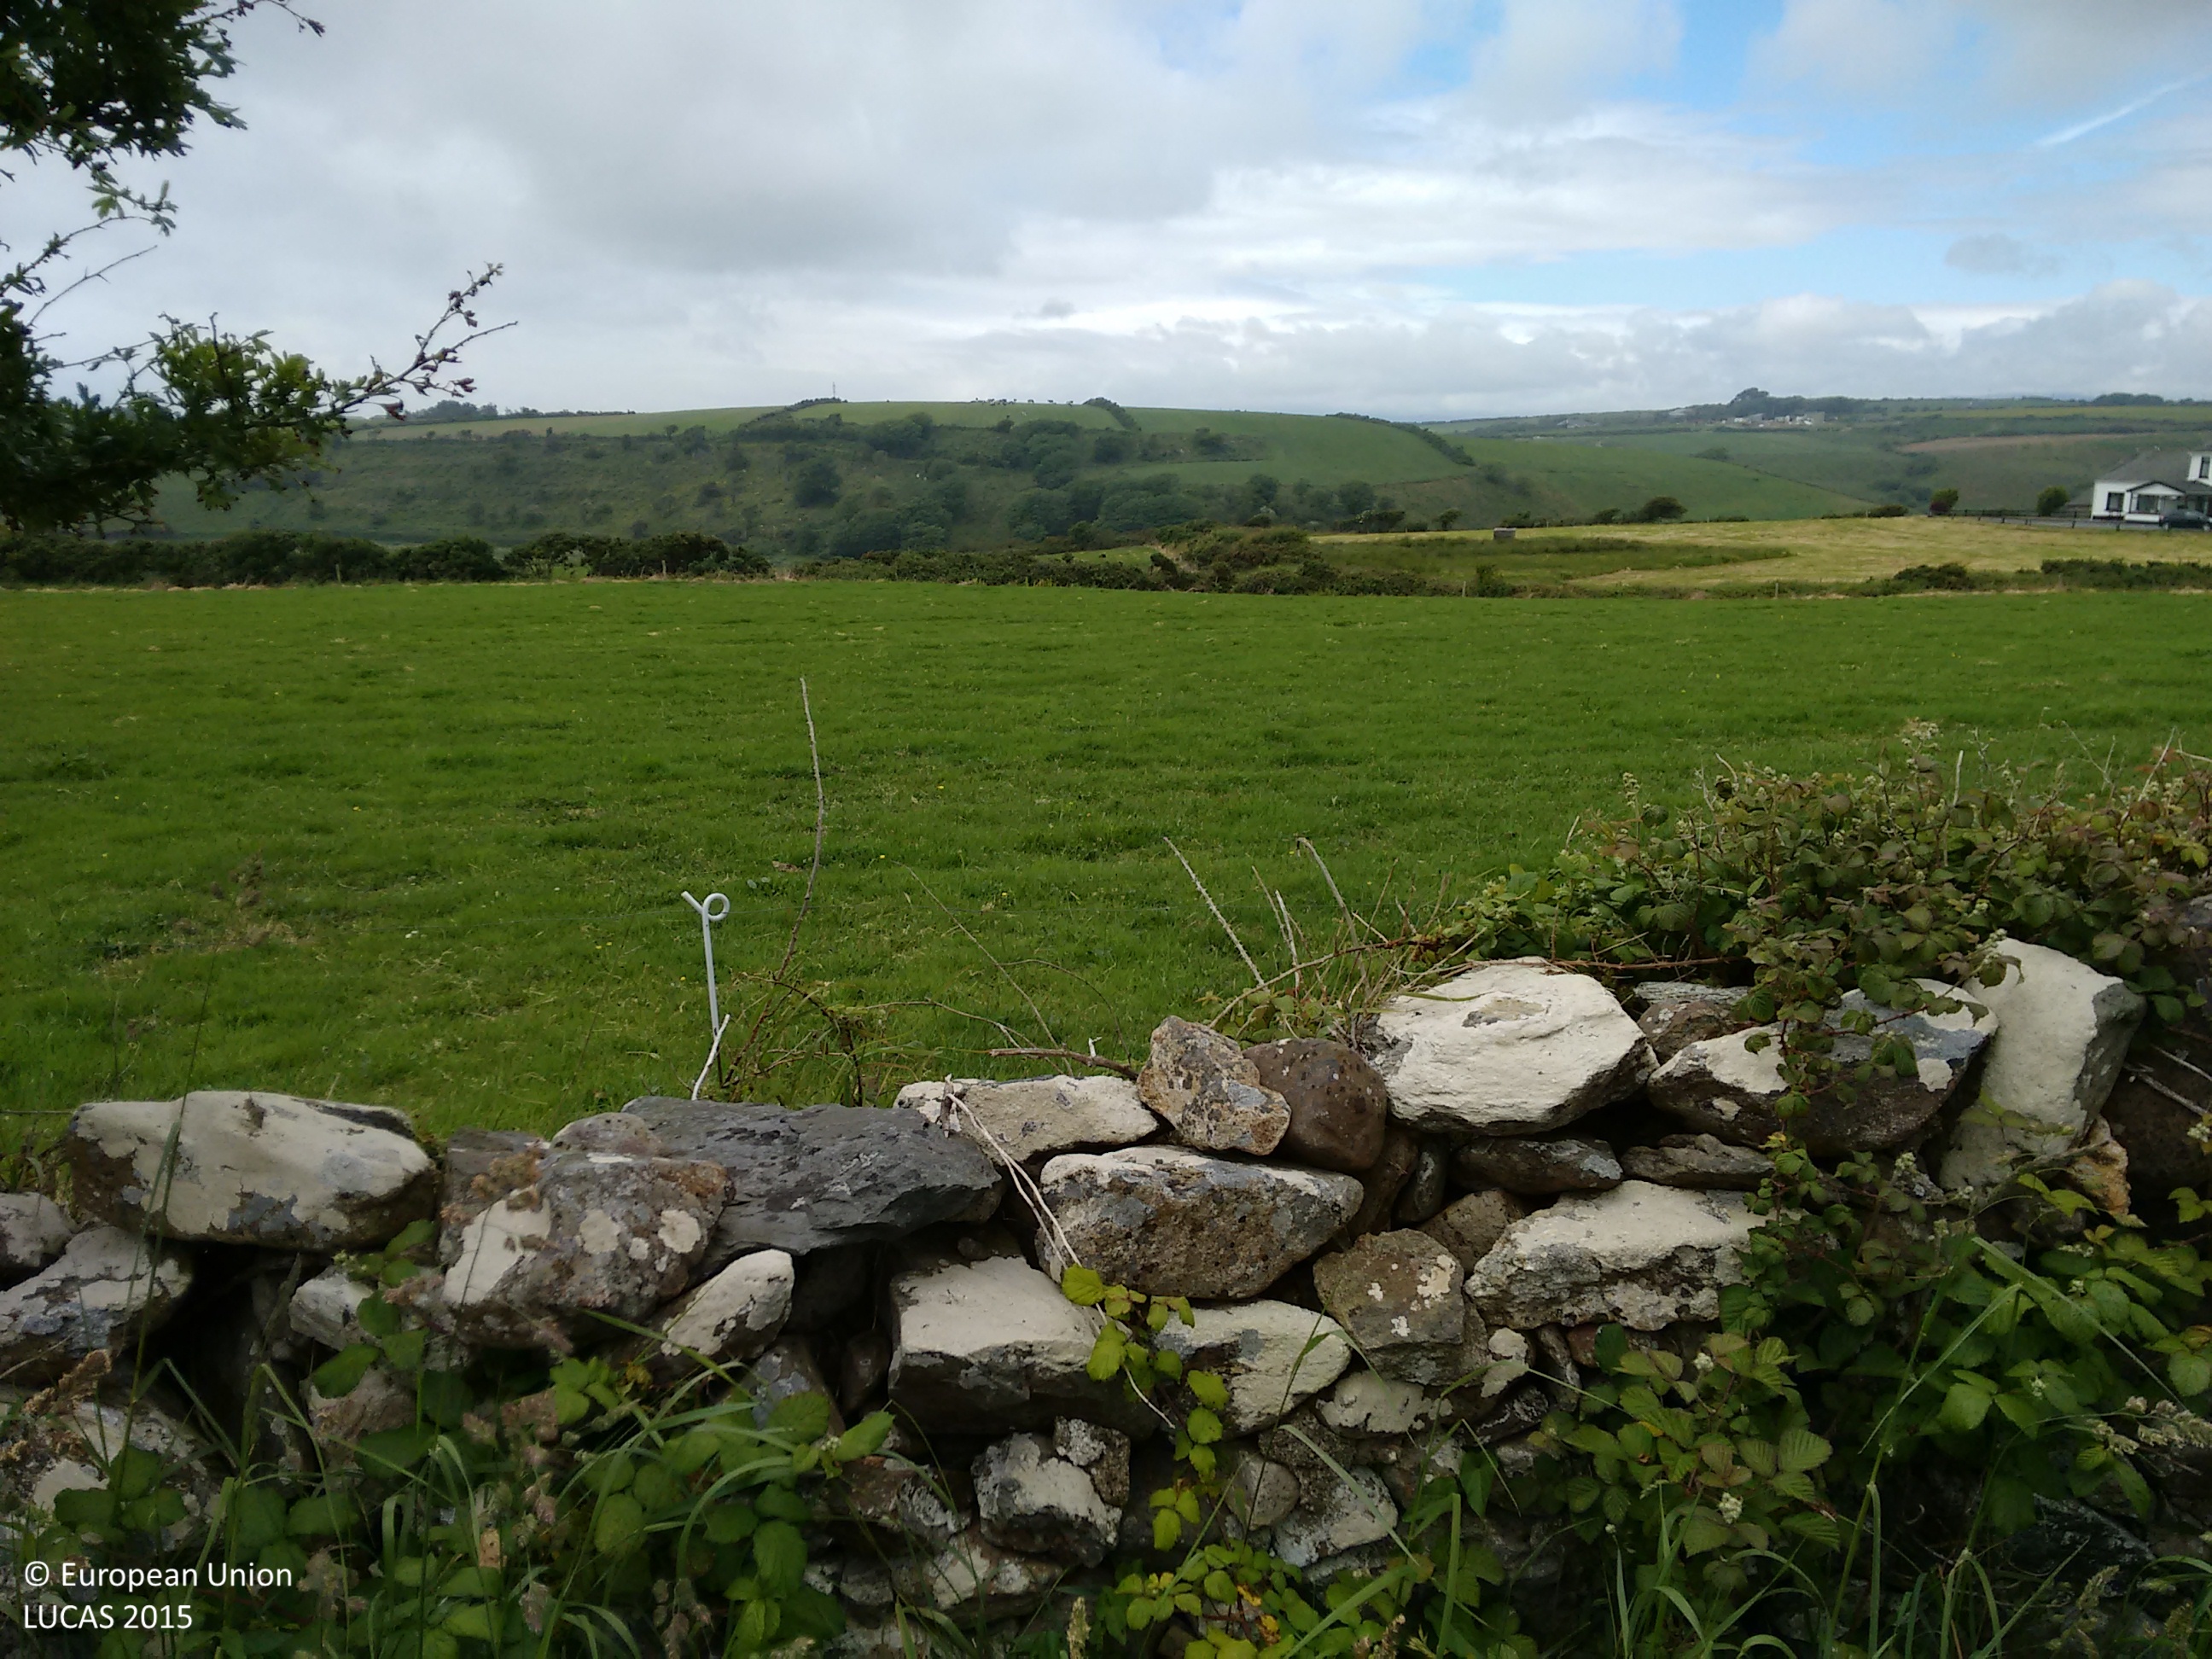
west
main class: Grassland
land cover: Grassland without tree/shrub cover
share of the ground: > 75 %
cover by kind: herbaceous plants 100 %
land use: Agriculture (excluding fallow land and kitchen gardens)
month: June
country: IE
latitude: 52.1477
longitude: -7.2645
